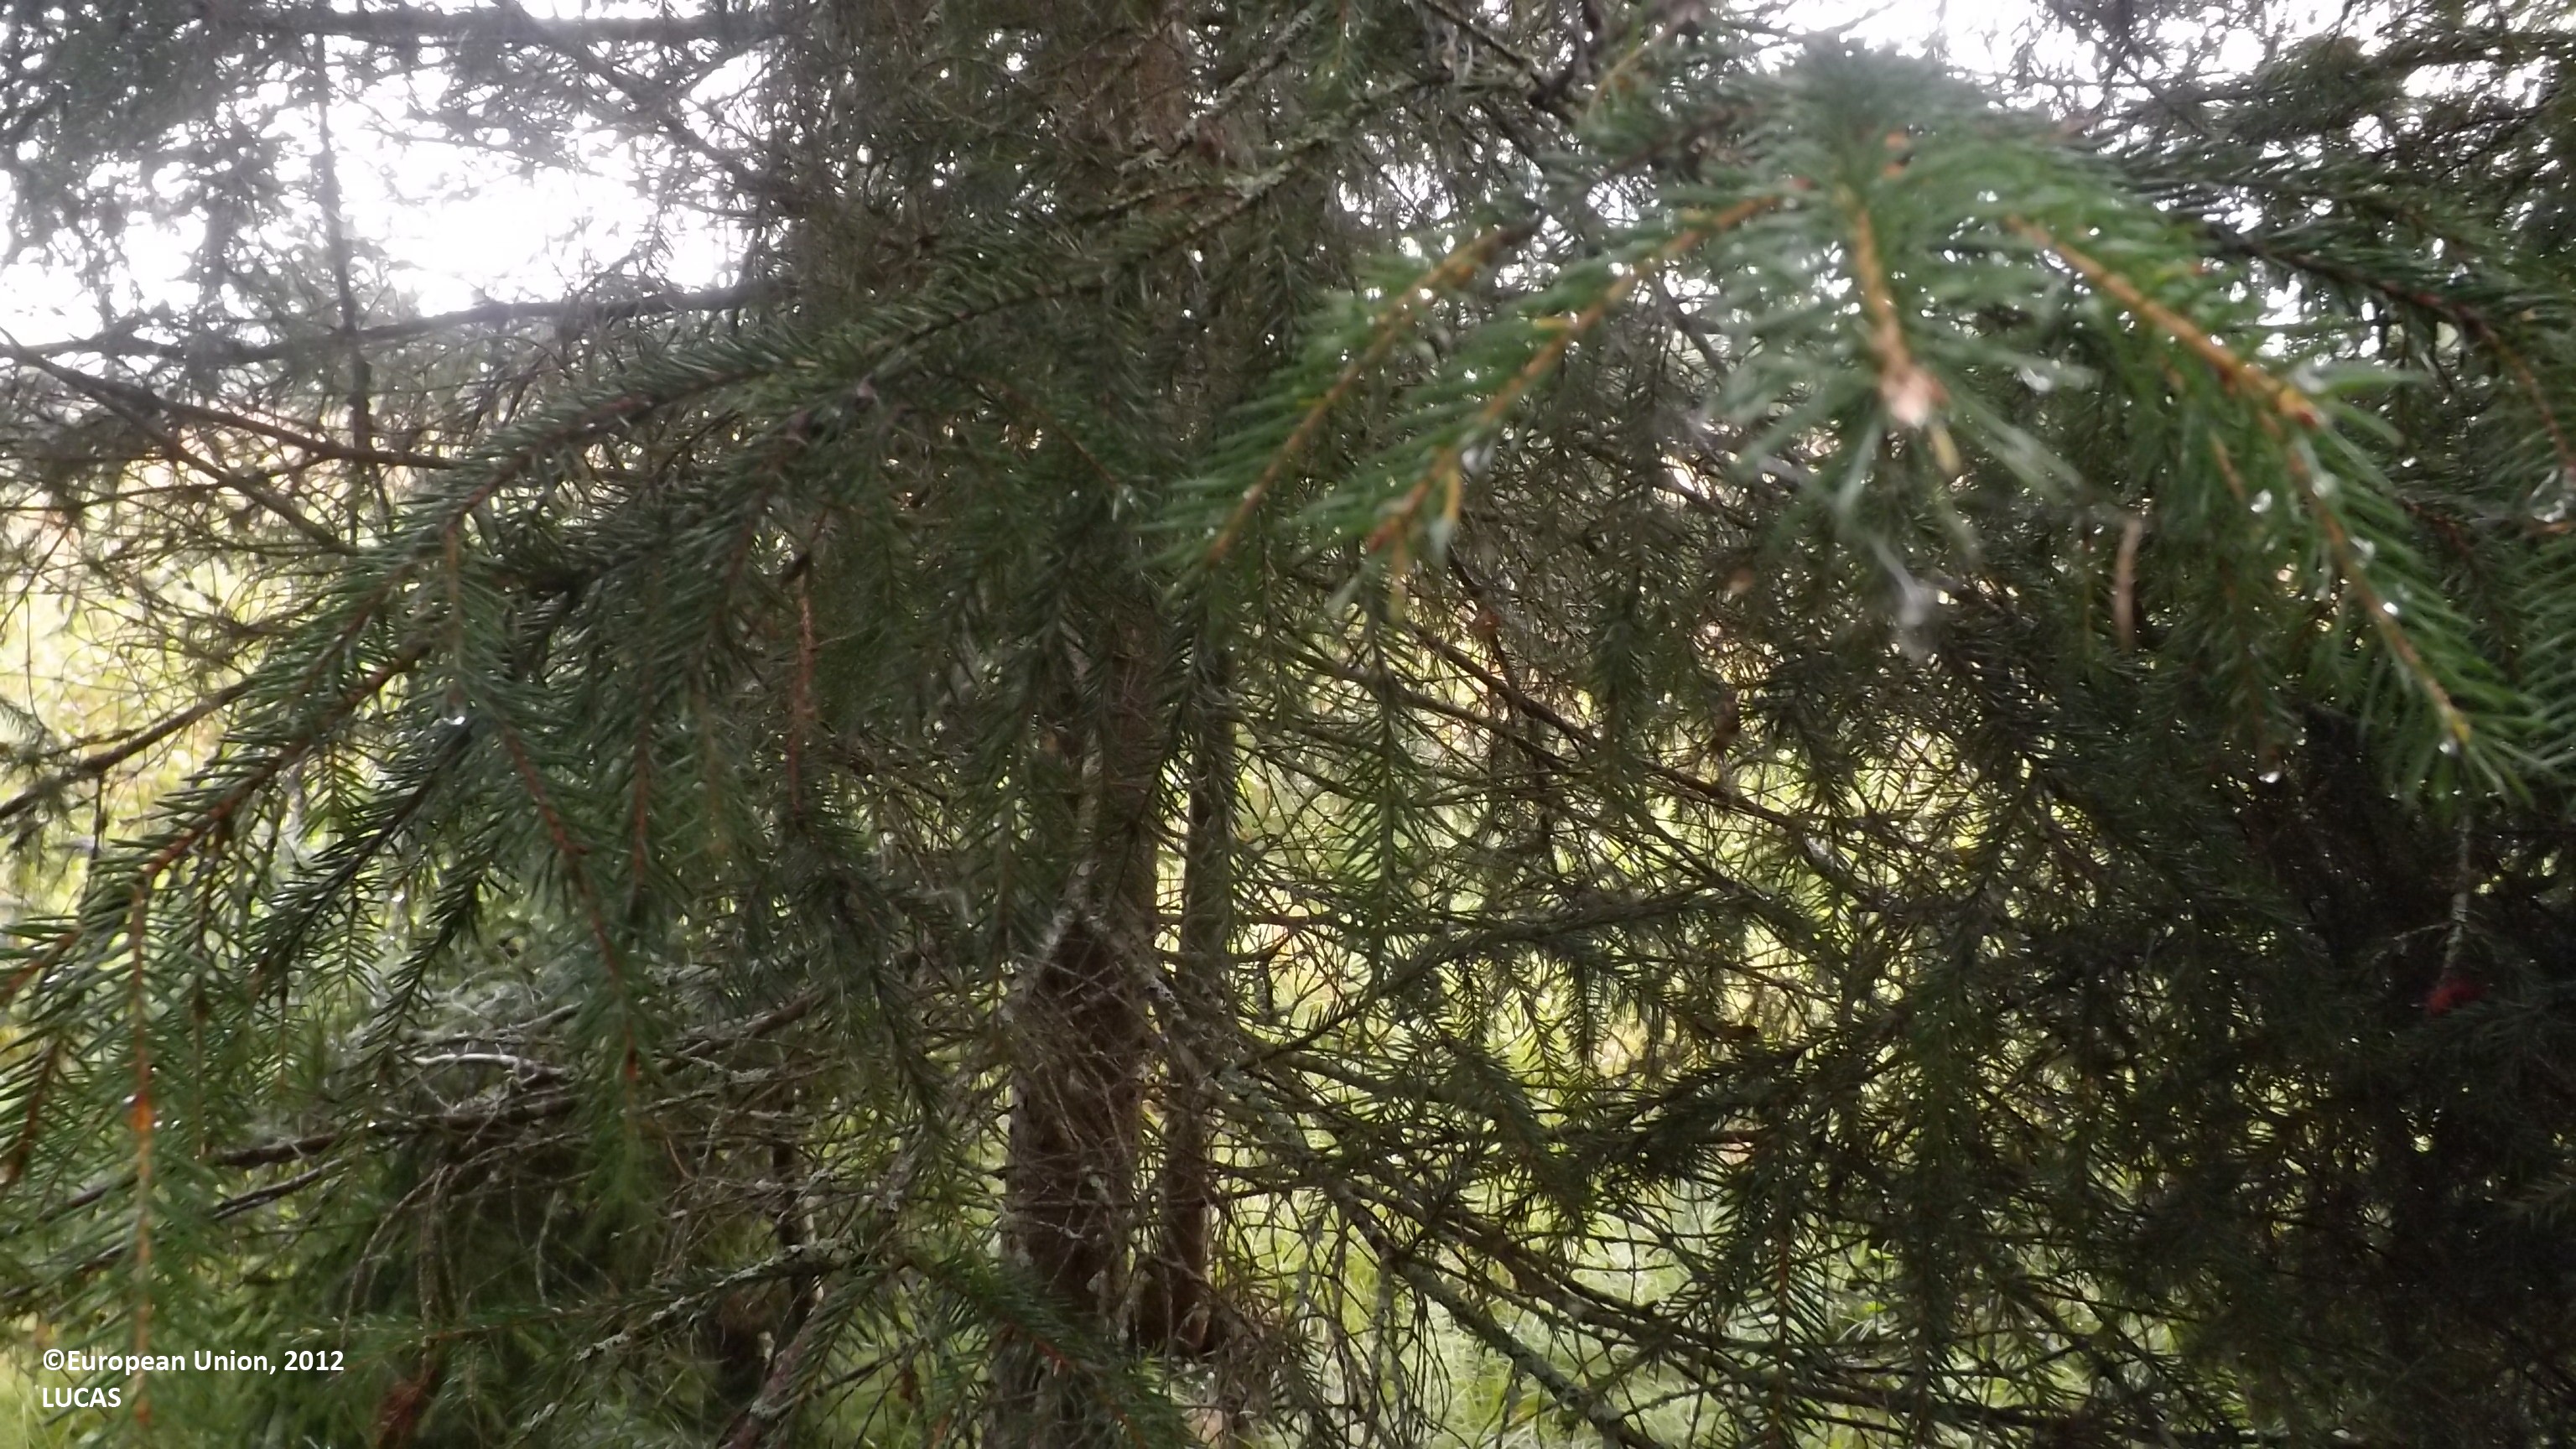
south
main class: Woodland
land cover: Spruce dominated mixed woodland
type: boreal forest
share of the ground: > 75 %
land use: Forestry
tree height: > 5 m
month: August
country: FI
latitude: 63.9710
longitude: 23.8498
